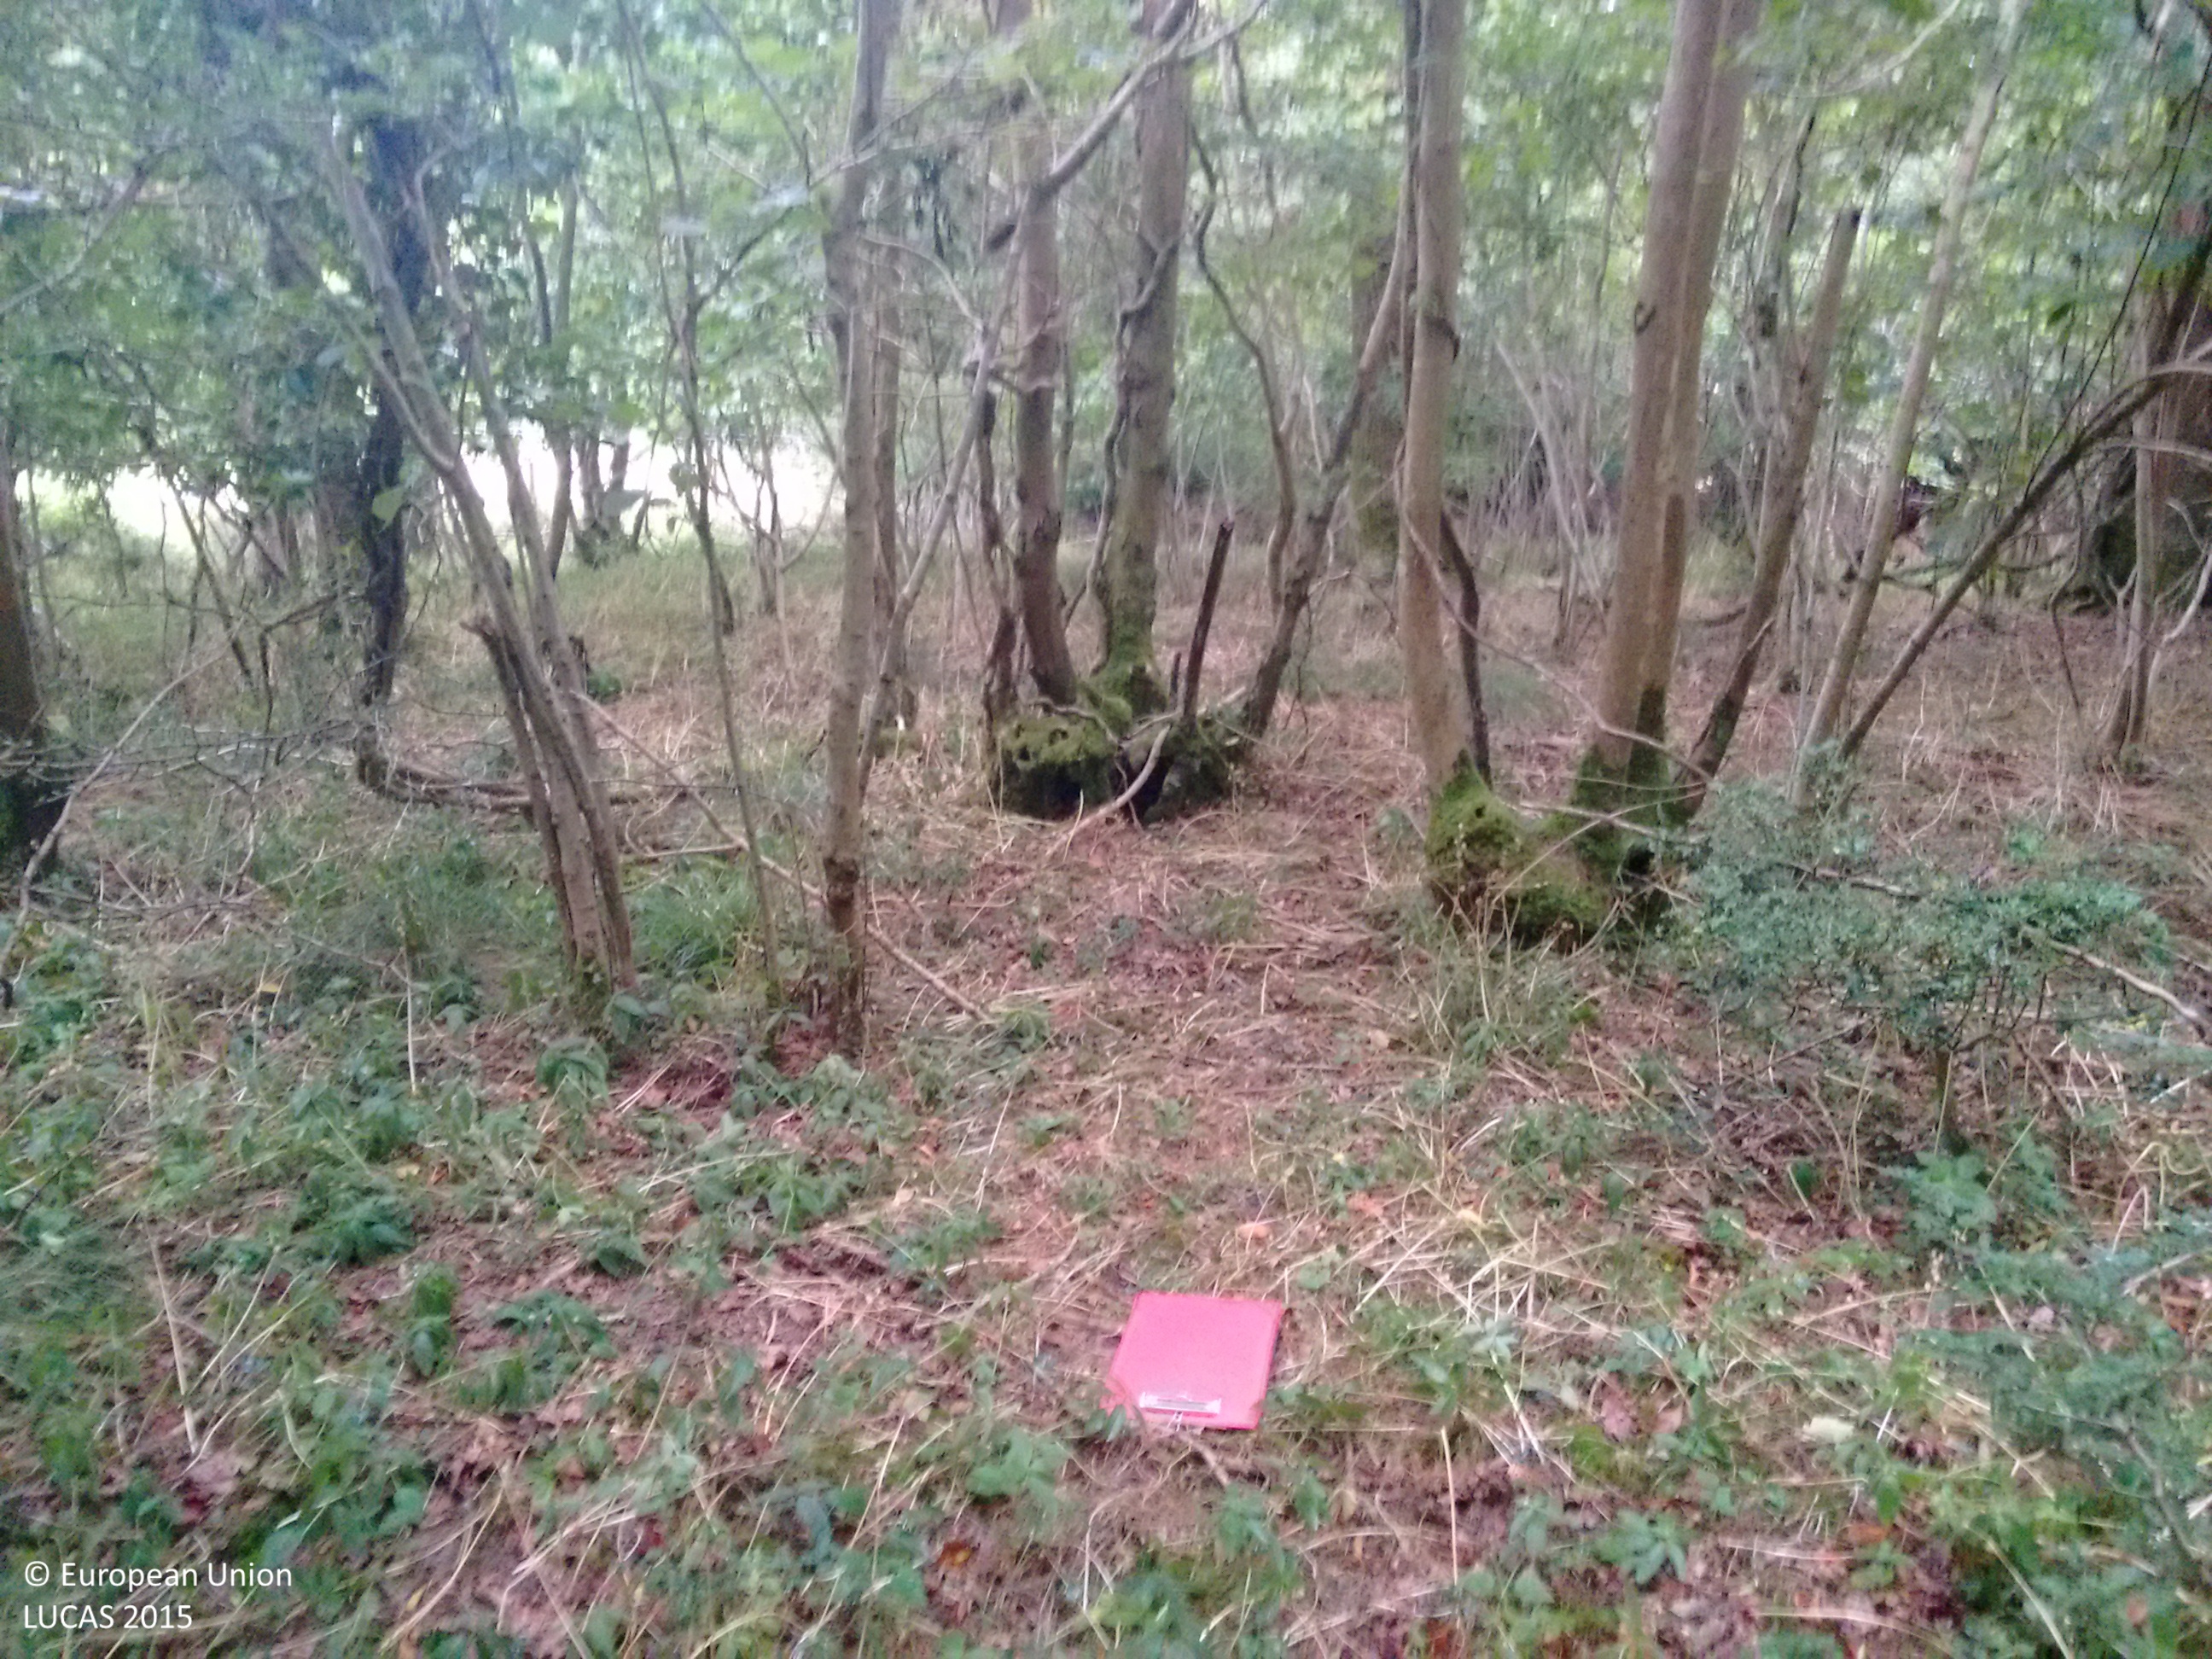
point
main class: Woodland
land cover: Broadleaved woodland
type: mesophytic deciduous forest
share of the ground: > 75 %
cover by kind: broadleaved forest trees 100 %
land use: Other primary production
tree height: > 5 m
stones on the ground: < 10 %
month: July
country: GB
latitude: 50.7442
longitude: -2.2065
